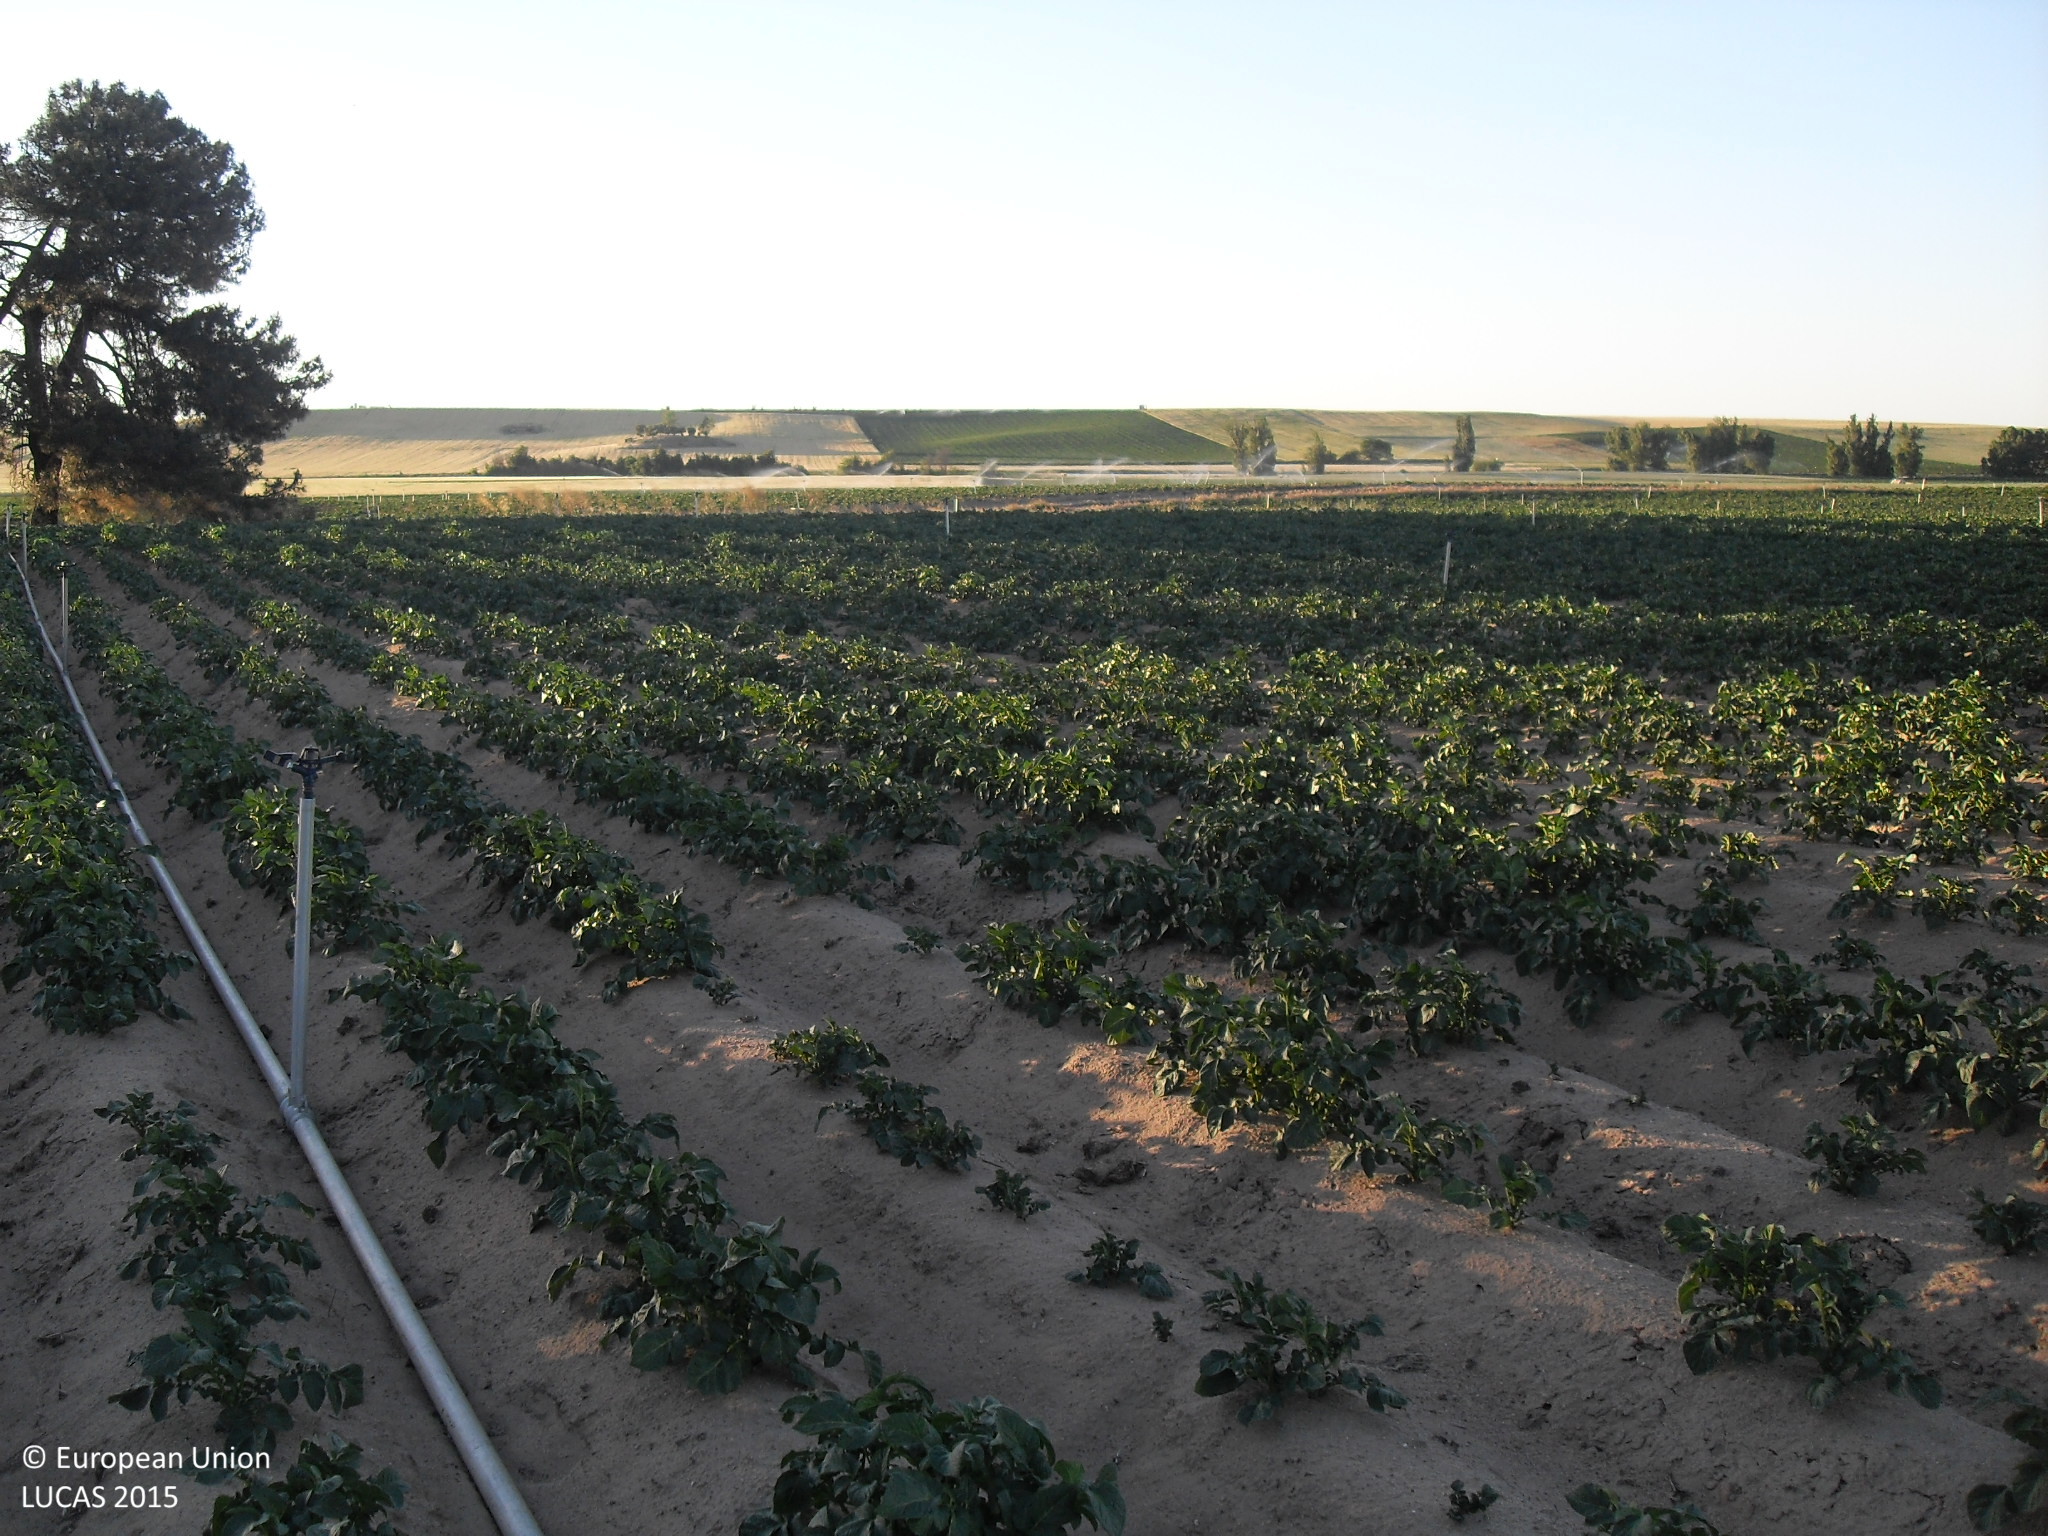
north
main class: Cropland
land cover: Potatoes
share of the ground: 25 - 50 %
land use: Agriculture (excluding fallow land and kitchen gardens)
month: May
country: ES
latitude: 41.0519
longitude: -5.3614
